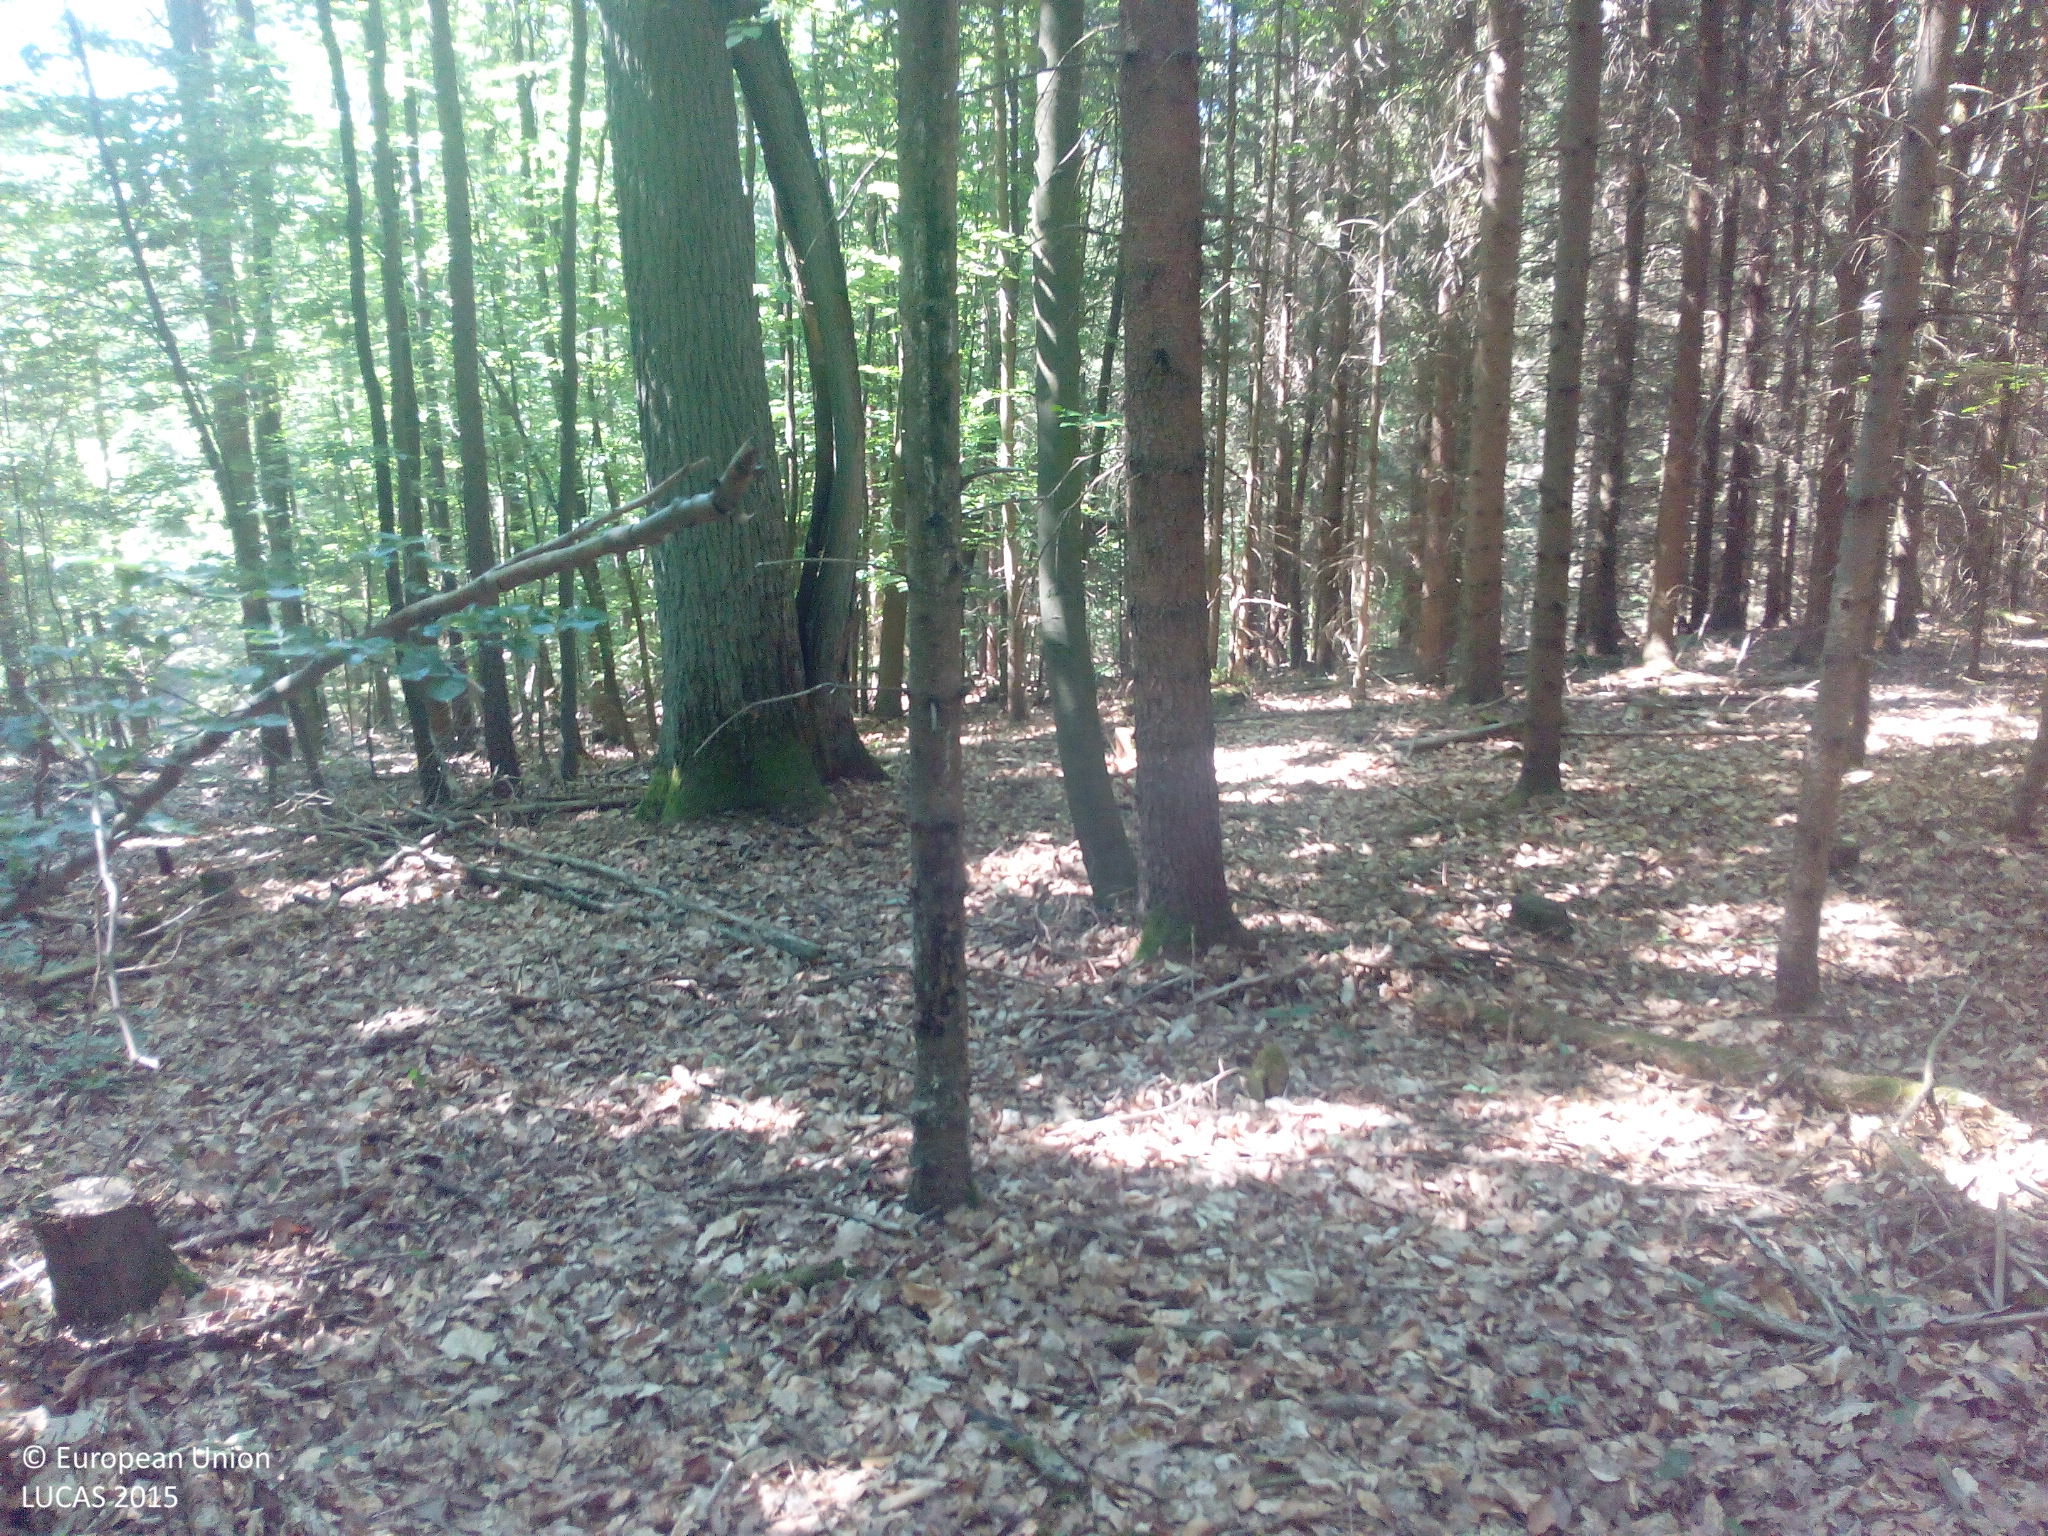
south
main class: Woodland
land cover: Spruce dominated mixed woodland
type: hemiboreal forest and nemoral coniferous forest and mixed broadleaved-coniferous forest
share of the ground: > 75 %
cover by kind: coniferous forest trees 70 %, broadleaved forest trees 25 %, unconsolidated bare surface 5 %
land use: Forestry
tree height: > 5 m
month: July
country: DE
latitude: 50.2529
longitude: 10.8553
